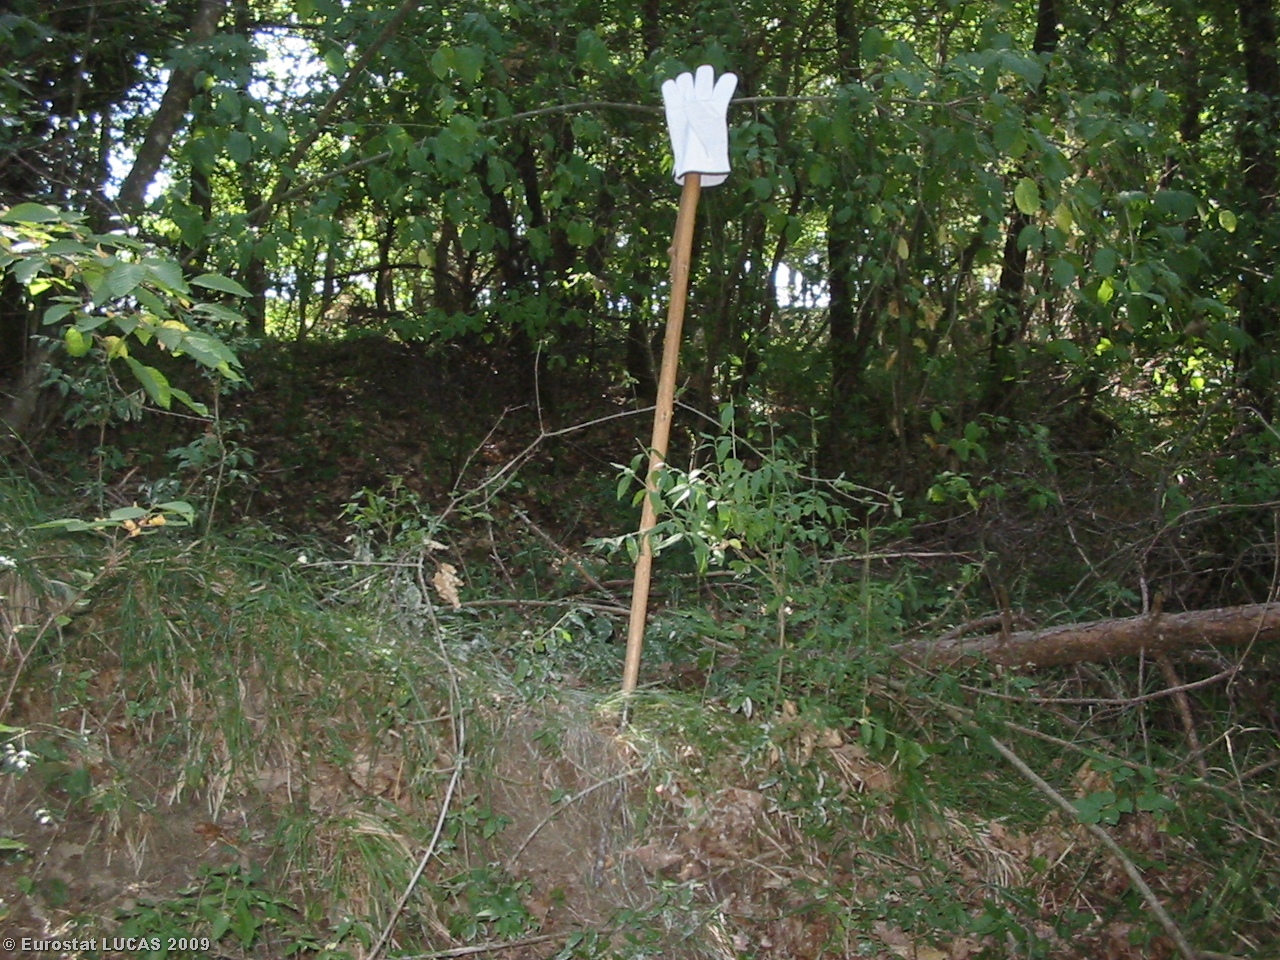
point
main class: Woodland
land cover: Mixed woodland
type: thermophilous deciduous forest
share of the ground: > 75 %
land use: Forestry
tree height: > 5 m
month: July
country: IT
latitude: 44.4582
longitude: 10.3386
